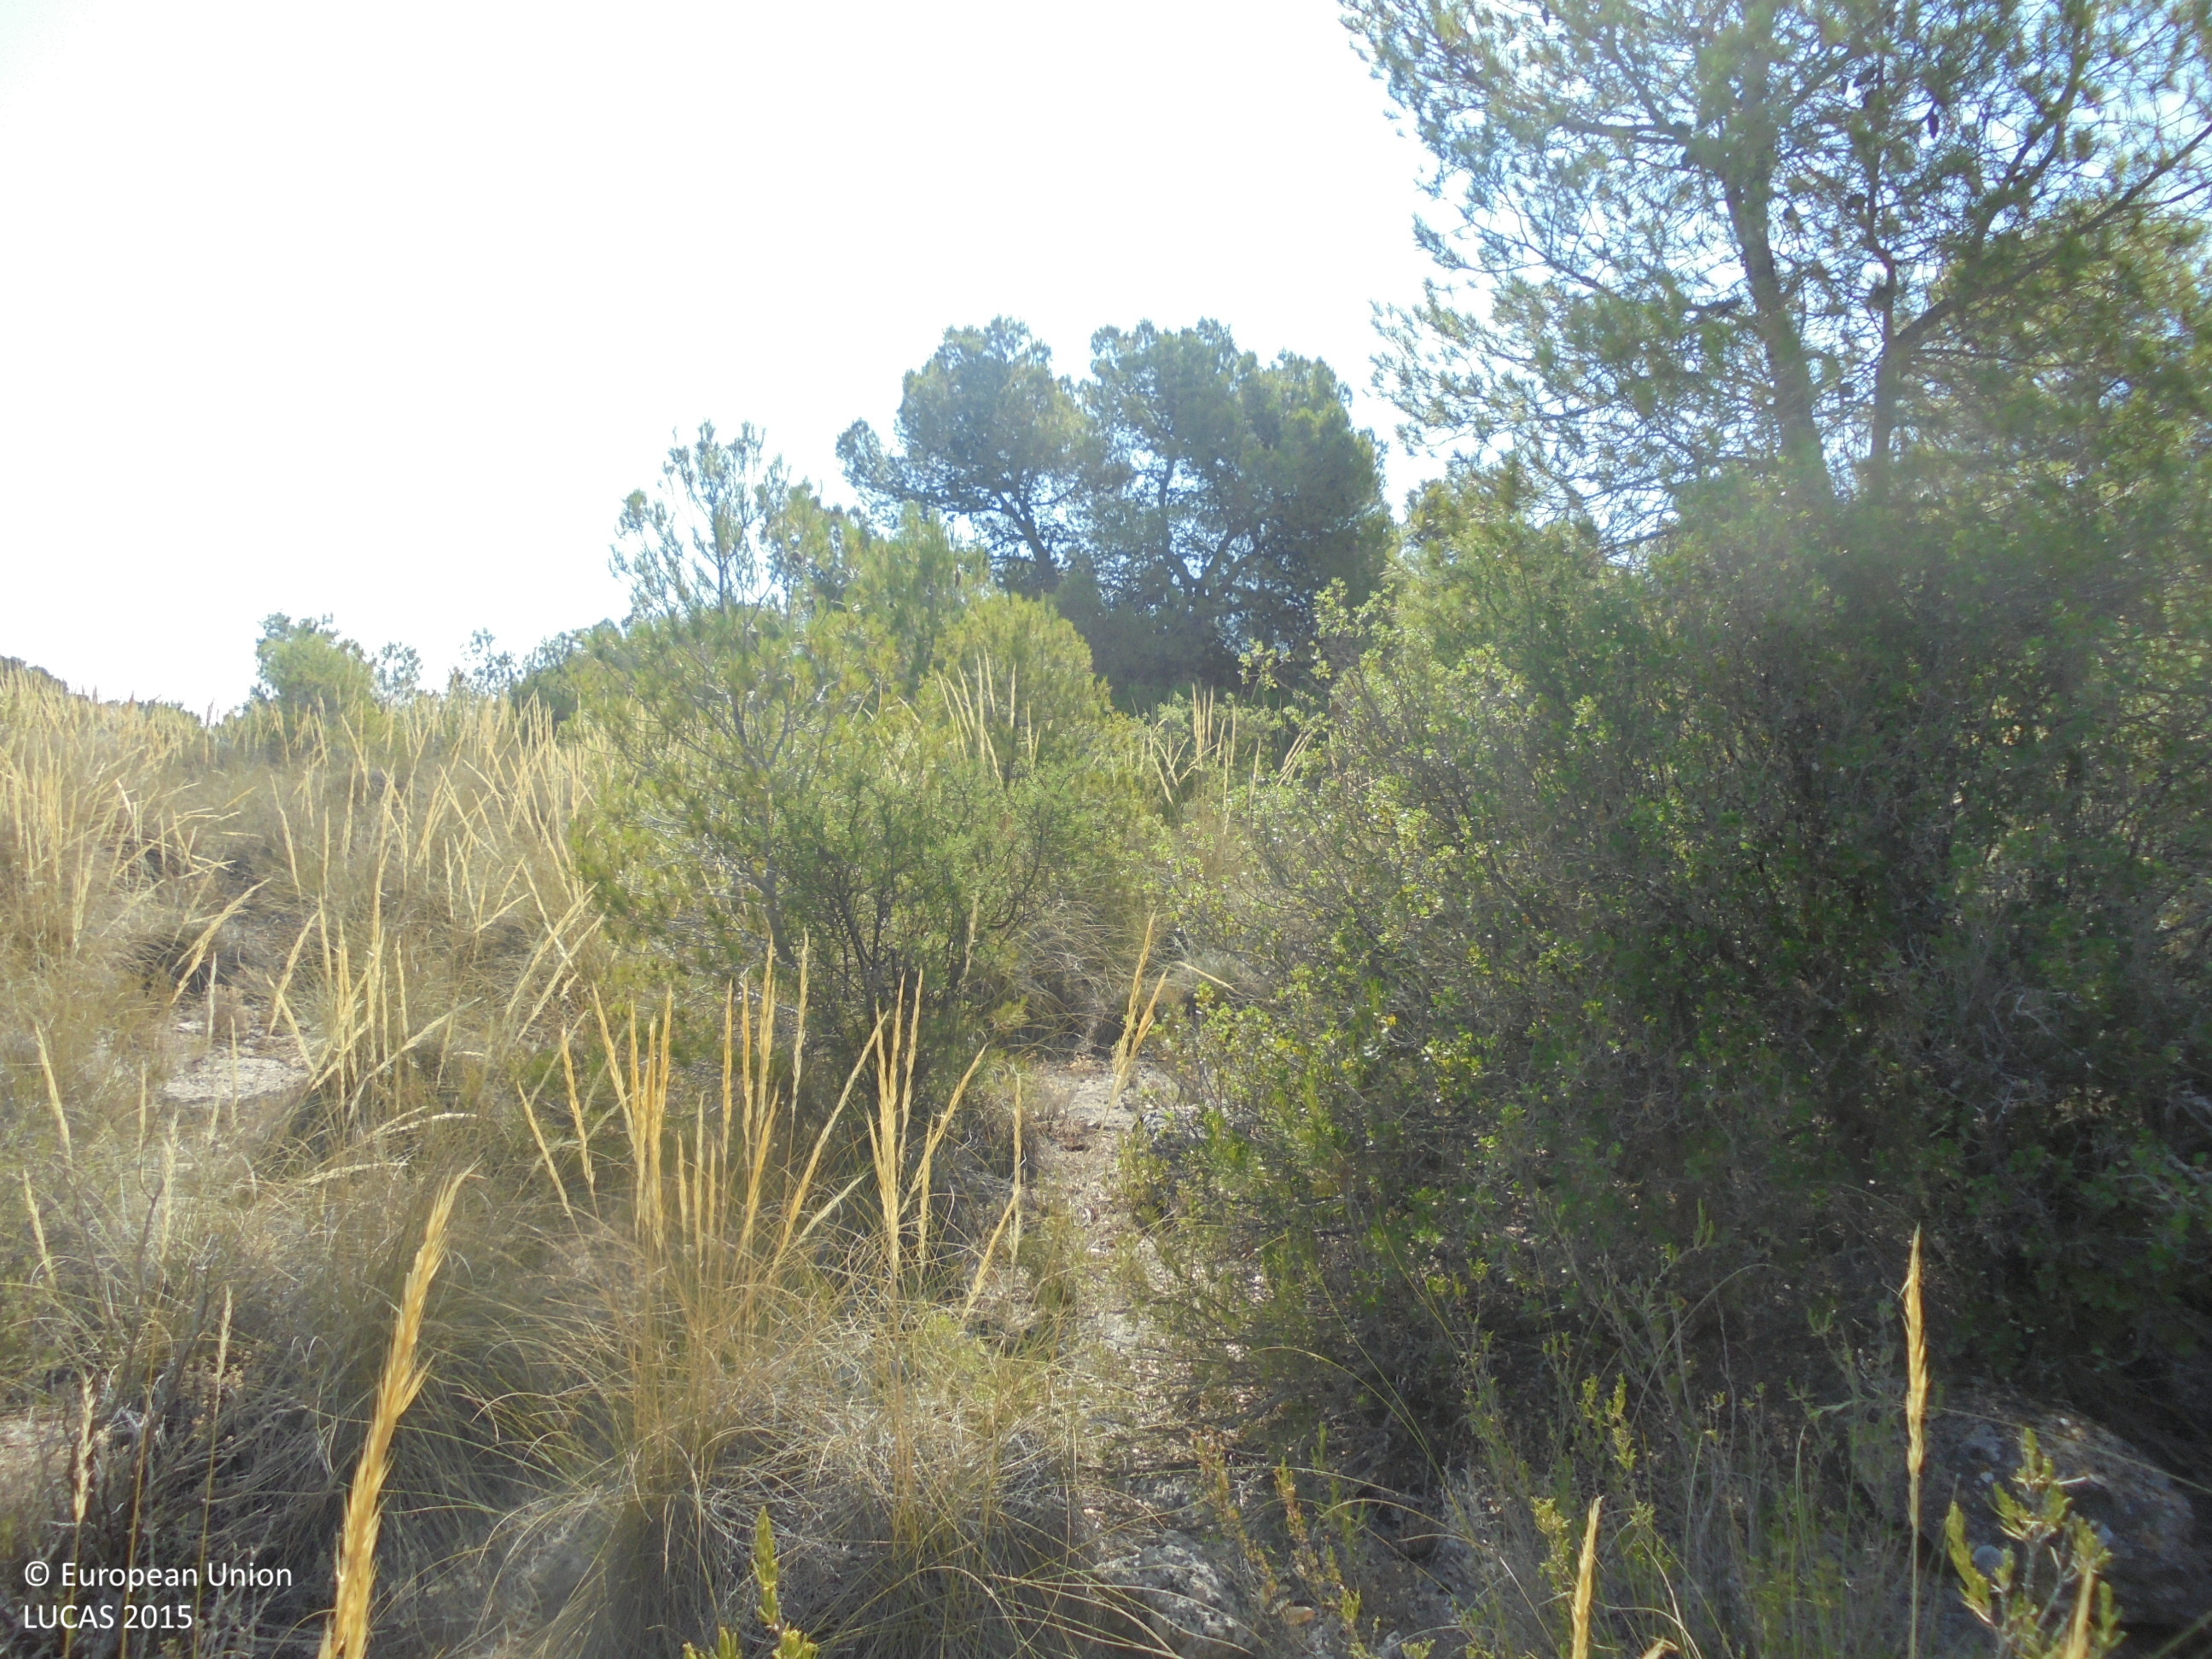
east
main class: Woodland
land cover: Pine dominated coniferous woodland
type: coniferous forest of the mediterranean region
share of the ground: 25 - 50 %
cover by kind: coniferous forest trees 45 %, shrubs 35 %, unconsolidated bare surface 20 %
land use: Semi-natural and natural areas not in use
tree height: > 5 m
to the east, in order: Pine dominated coniferous woodland; Shrubland without tree cover
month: July
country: ES
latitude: 38.5348
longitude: -1.4526
